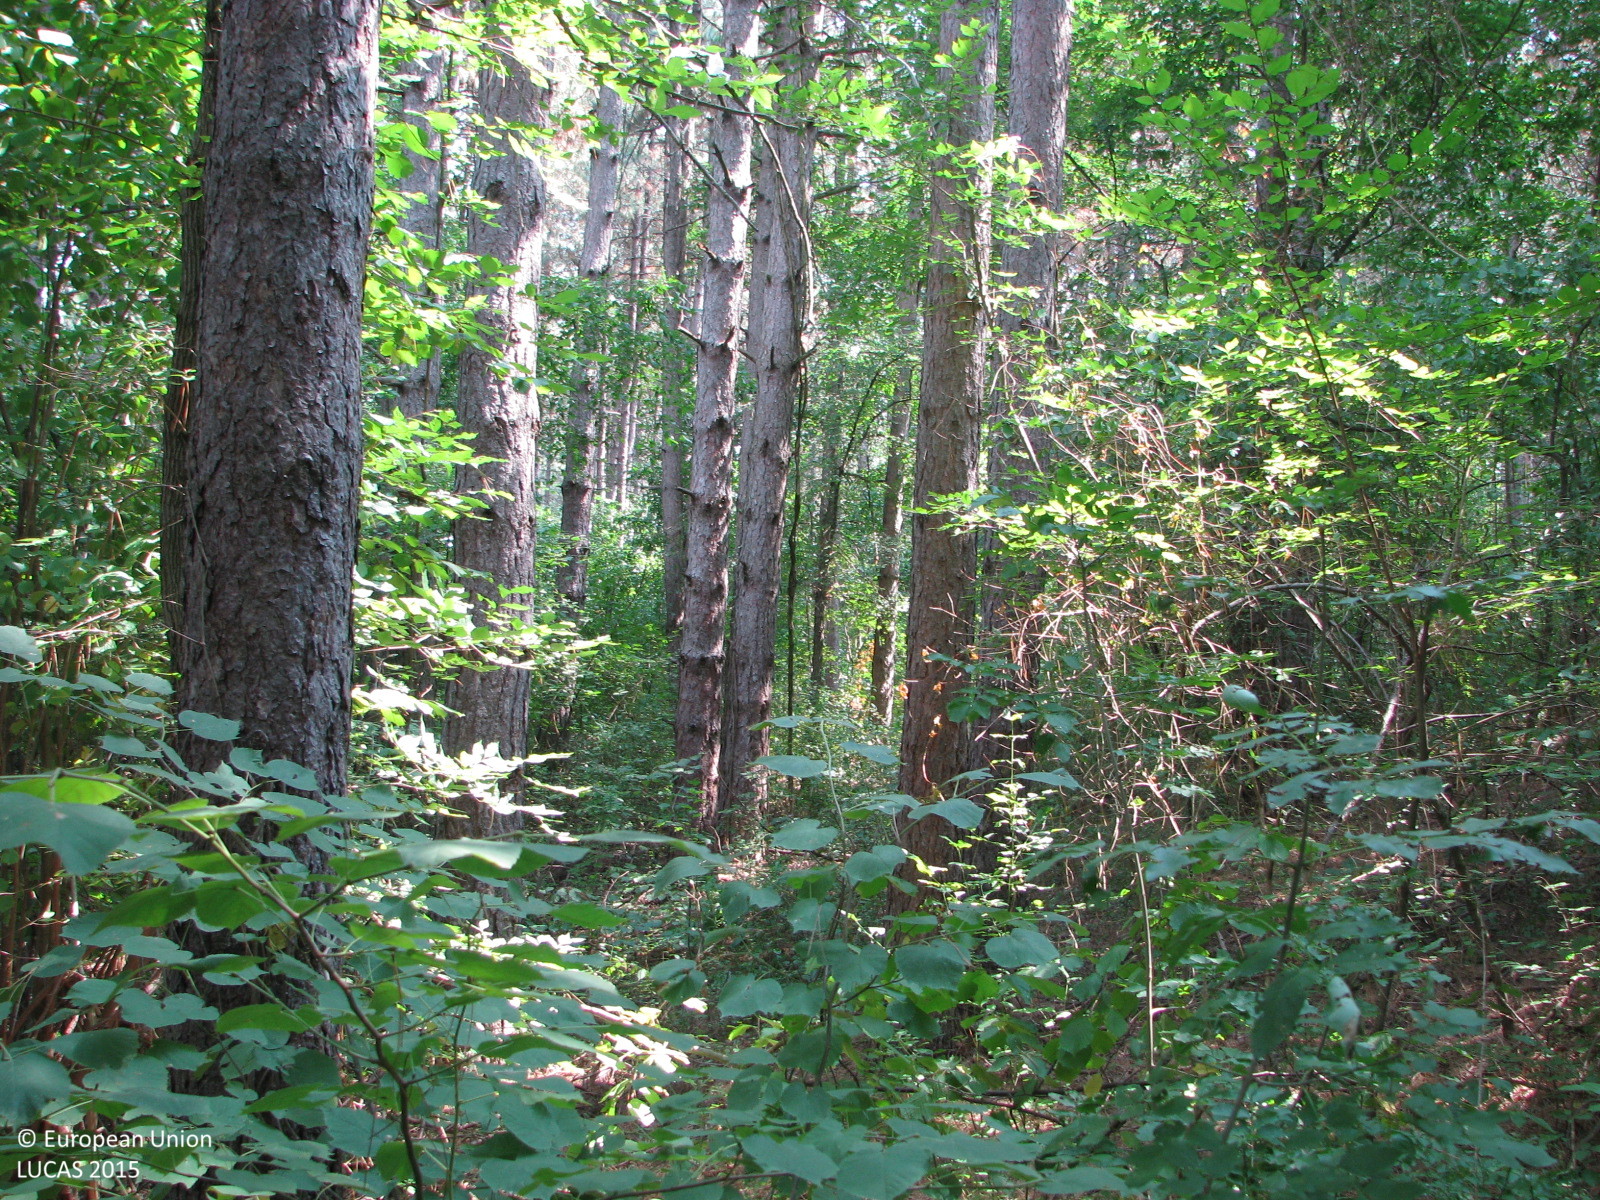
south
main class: Woodland
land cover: Pine dominated mixed woodland
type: hemiboreal forest and nemoral coniferous forest and mixed broadleaved-coniferous forest
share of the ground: 50 - 75 %
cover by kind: coniferous forest trees 50 %, broadleaved forest trees 20 %, shrubs 15 %, unconsolidated bare surface 15 %
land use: Forestry
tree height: > 5 m
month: August
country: BG
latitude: 42.5839
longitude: 26.0076
